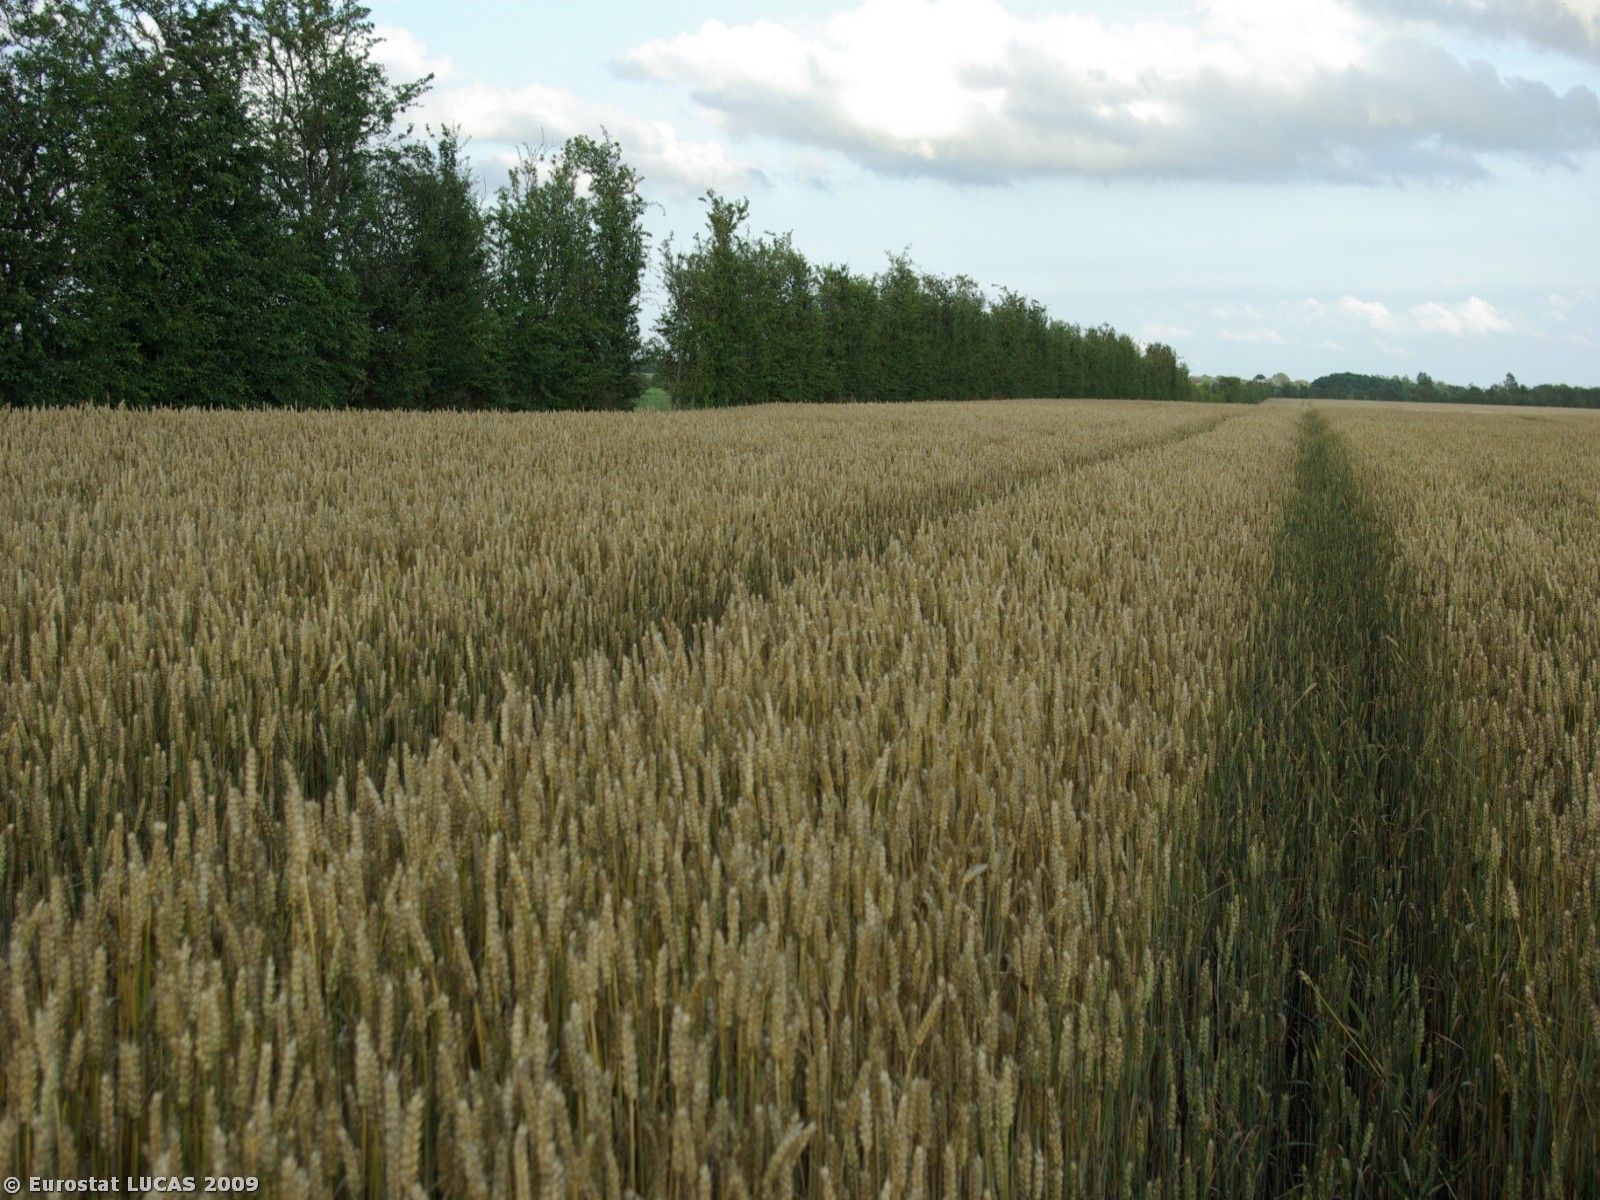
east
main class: Cropland
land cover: Common wheat
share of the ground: > 75 %
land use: Agriculture (excluding fallow land and kitchen gardens)
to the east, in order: Common wheat; Abandoned hedges; Fences; Grassland without tree/shrub cover; Fences; Grassland without tree/shrub cover
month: July
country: DK
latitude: 55.1414
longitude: 9.0125
